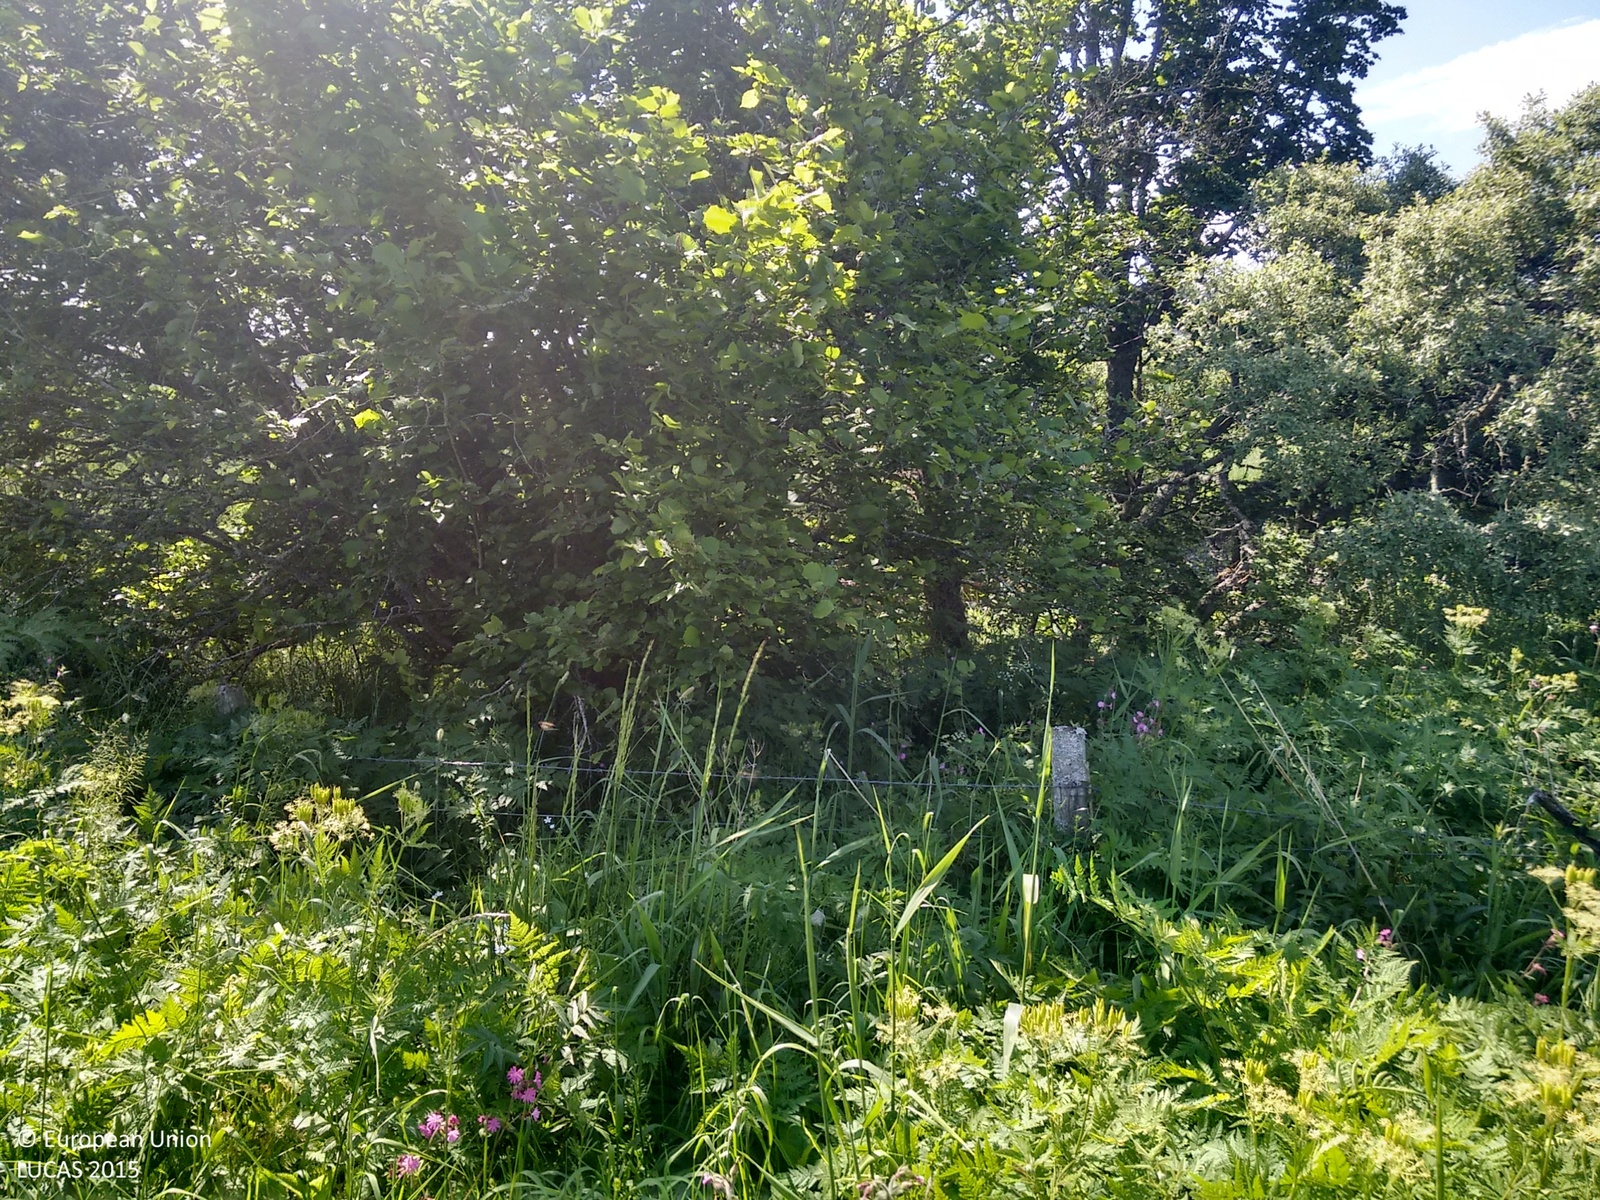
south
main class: Woodland
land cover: Broadleaved woodland
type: mesophytic deciduous forest
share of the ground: > 75 %
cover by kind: herbaceous plants 60 %, broadleaved forest trees 30 %, shrubs 10 %
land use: Semi-natural and natural areas not in use
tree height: > 5 m
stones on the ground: < 10 %
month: July
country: GB
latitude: 57.4509
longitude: -2.8745
